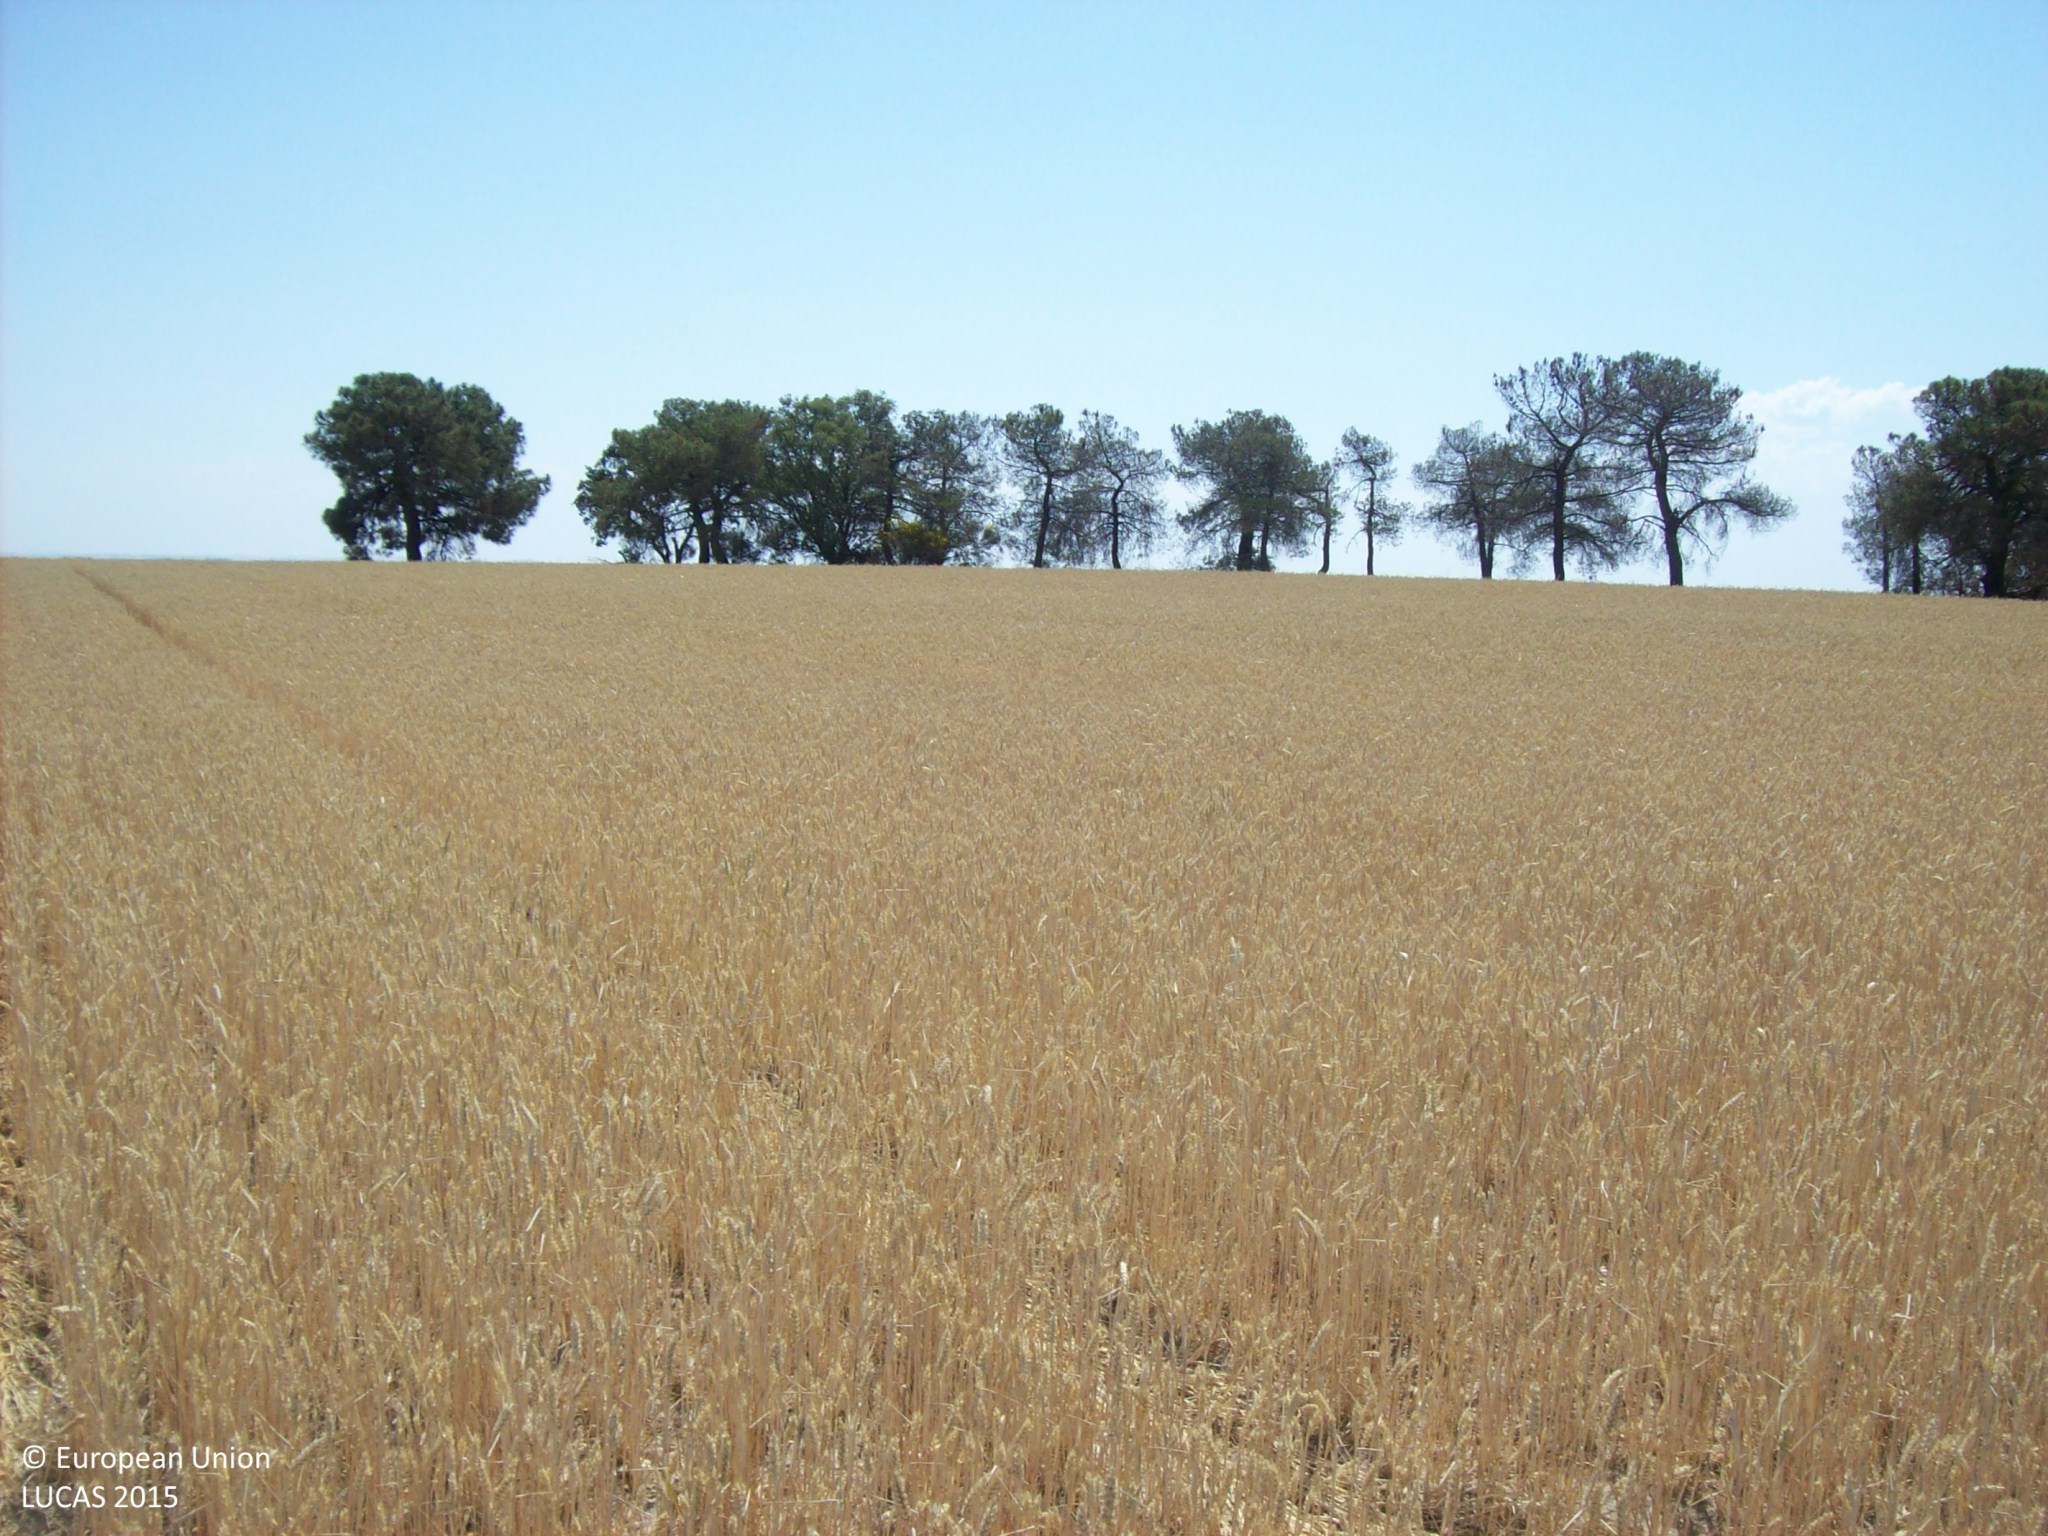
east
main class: Cropland
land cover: Common wheat
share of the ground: > 75 %
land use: Agriculture (excluding fallow land and kitchen gardens)
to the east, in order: Common wheat; Pine dominated coniferous woodland; Common wheat
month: June
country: ES
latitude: 41.1910
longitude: -5.0561
